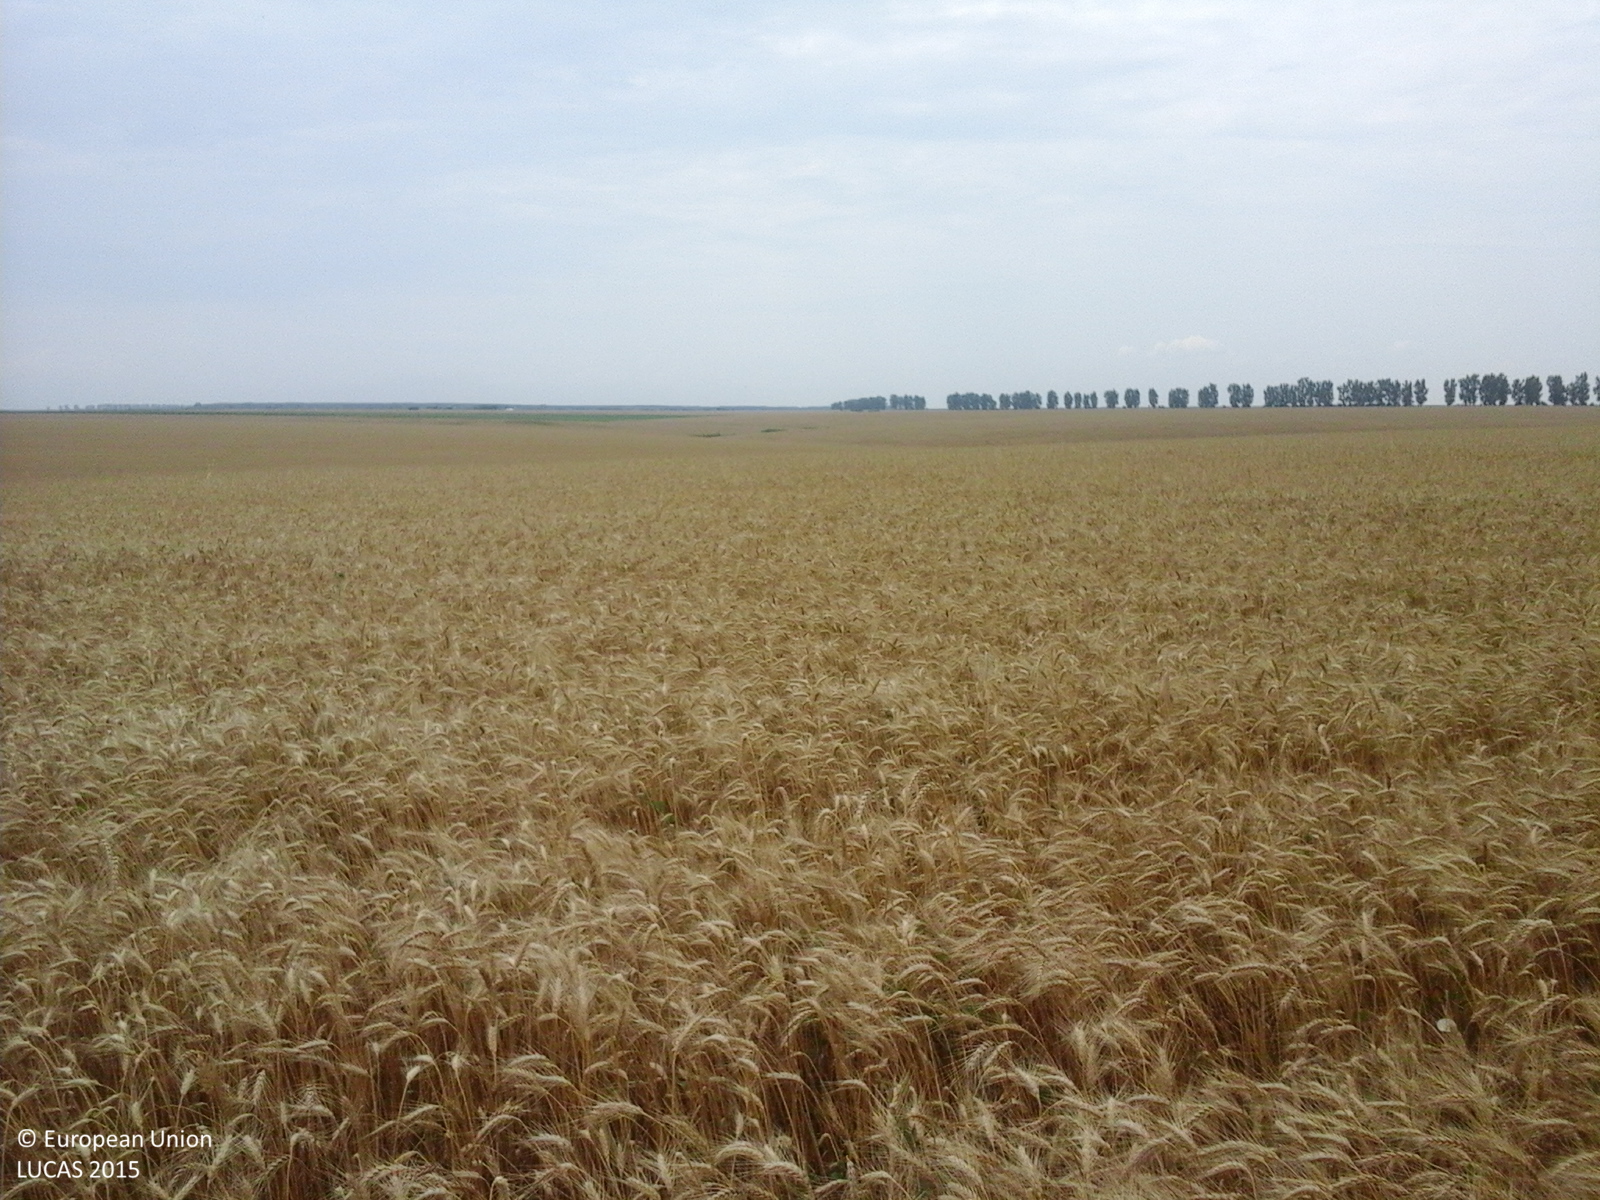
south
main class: Cropland
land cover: Common wheat
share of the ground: > 75 %
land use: Agriculture (excluding fallow land and kitchen gardens)
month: July
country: RO
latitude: 44.1252
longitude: 25.7783
